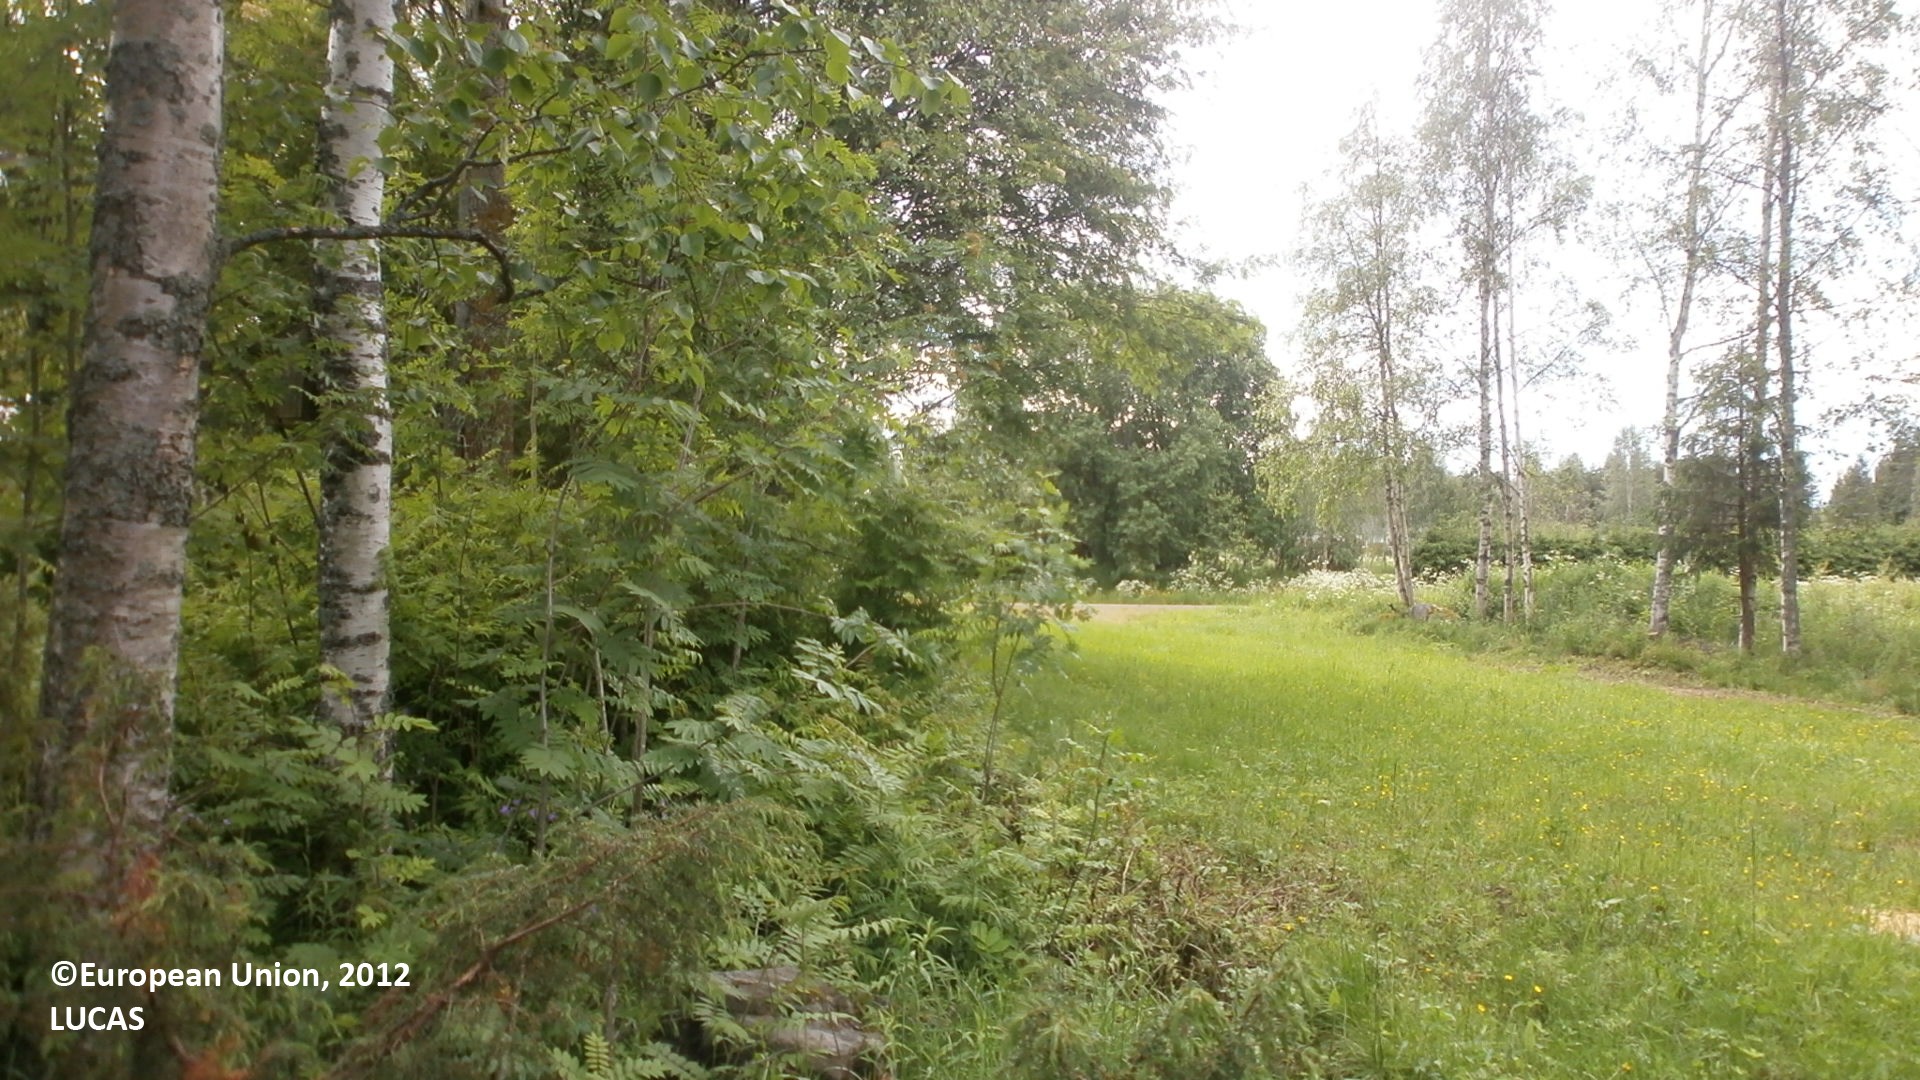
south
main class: Woodland
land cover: Broadleaved woodland
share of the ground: 50 - 75 %
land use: Residential
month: June
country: FI
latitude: 64.2984
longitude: 24.8971
